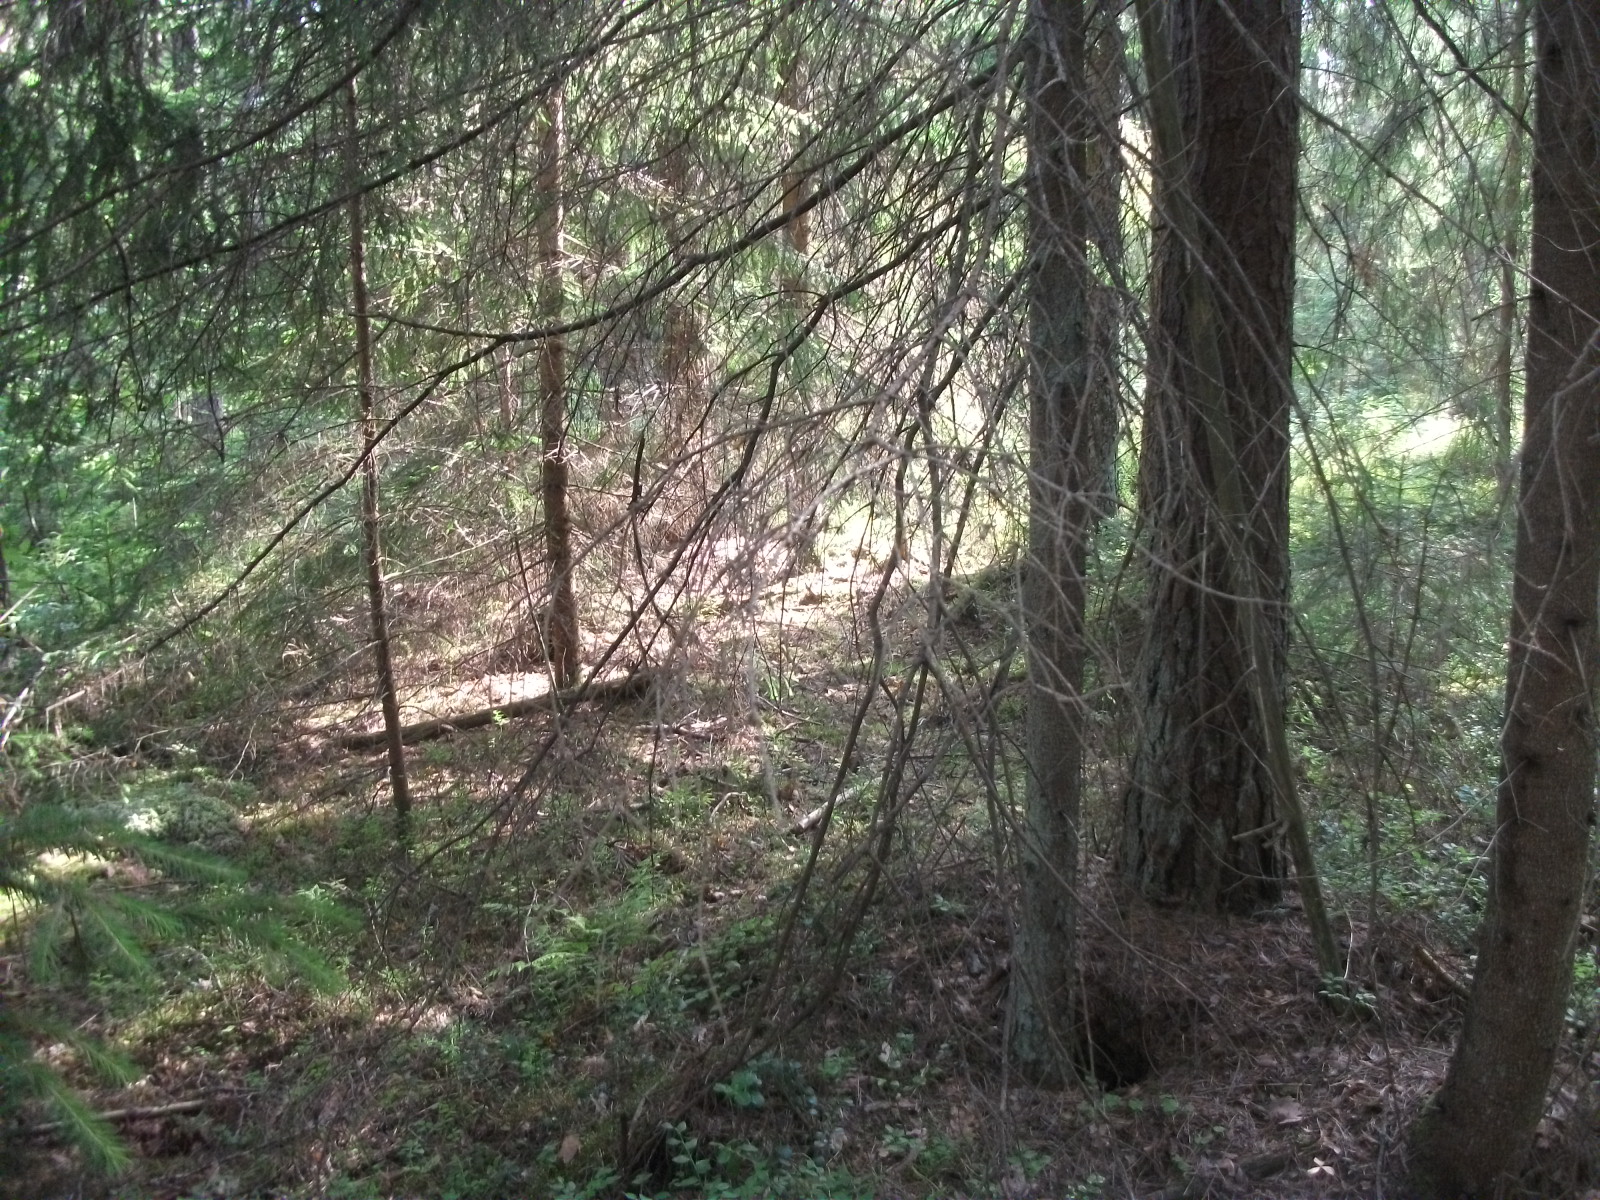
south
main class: Woodland
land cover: Other coniferous woodland
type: hemiboreal forest and nemoral coniferous forest and mixed broadleaved-coniferous forest
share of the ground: > 75 %
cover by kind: coniferous forest trees 95 %, lichens and mosses 5 %
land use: Forestry
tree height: > 5 m
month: August
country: LV
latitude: 56.8359
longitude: 26.5210
